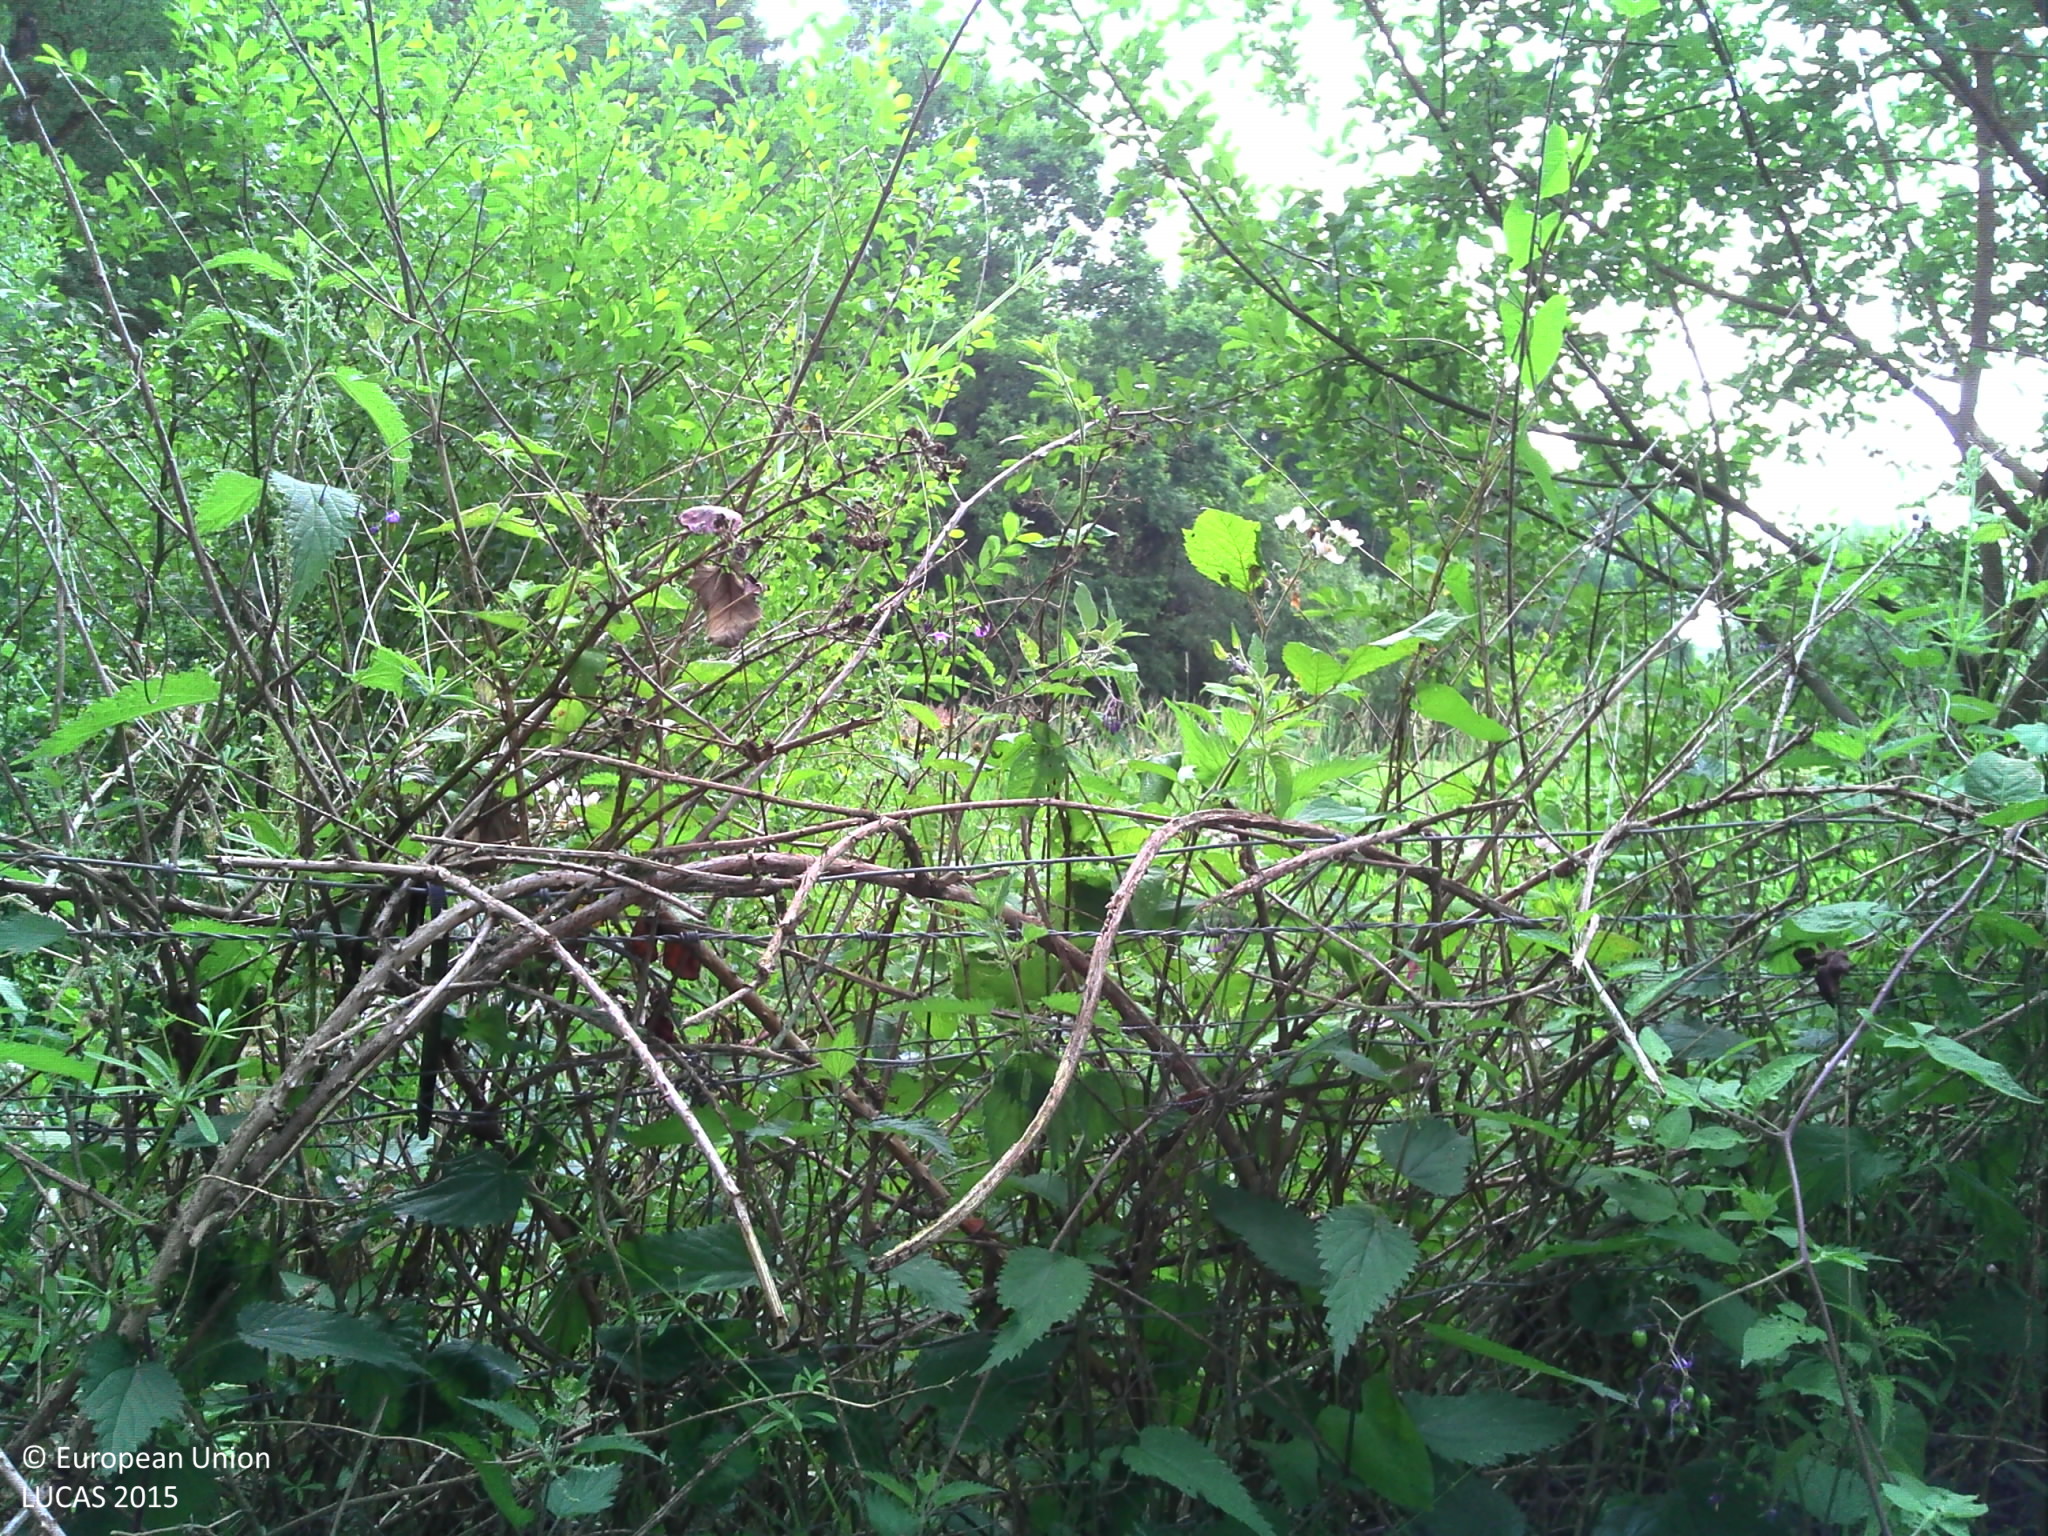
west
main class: Woodland
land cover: Spruce dominated mixed woodland
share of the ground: > 75 %
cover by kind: broadleaved forest trees 55 %, coniferous forest trees 40 %, herbaceous plants 5 %
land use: Semi-natural and natural areas not in use
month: June
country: FR
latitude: 48.4861
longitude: -1.7265
